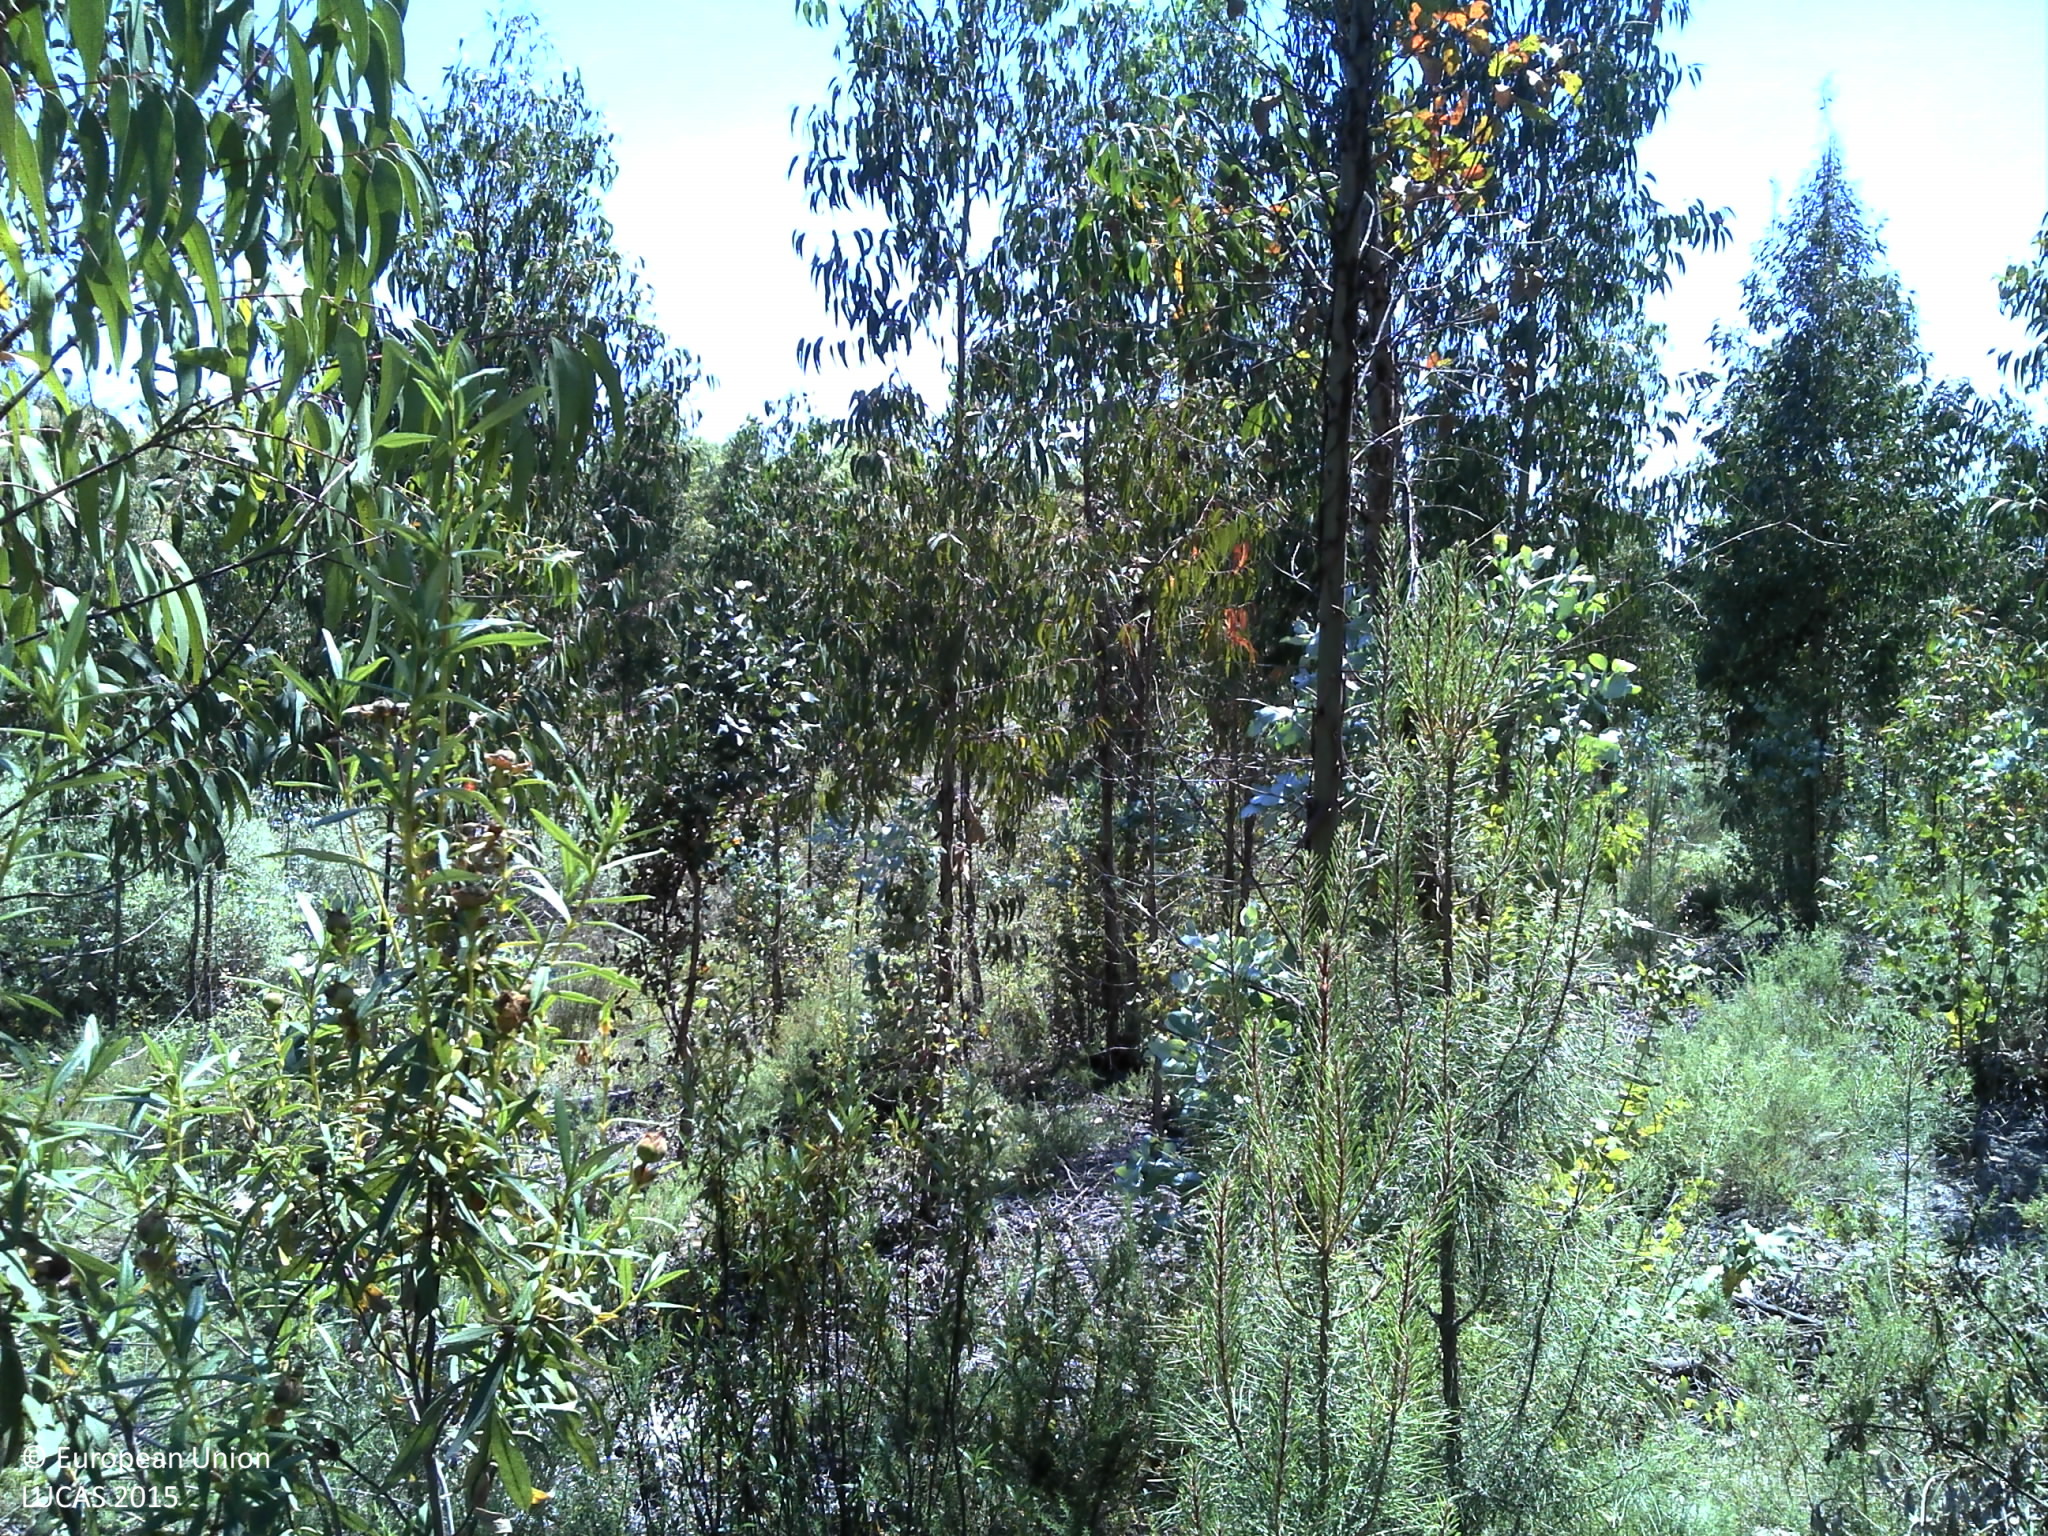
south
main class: Woodland
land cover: Broadleaved woodland
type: exotic forest
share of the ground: 25 - 50 %
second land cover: Shrubland without tree cover
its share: 50 - 75 %
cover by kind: broadleaved forest trees 50 %, shrubs 50 %
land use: Forestry
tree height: > 5 m
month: May
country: PT
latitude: 39.2074
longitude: -7.9444
